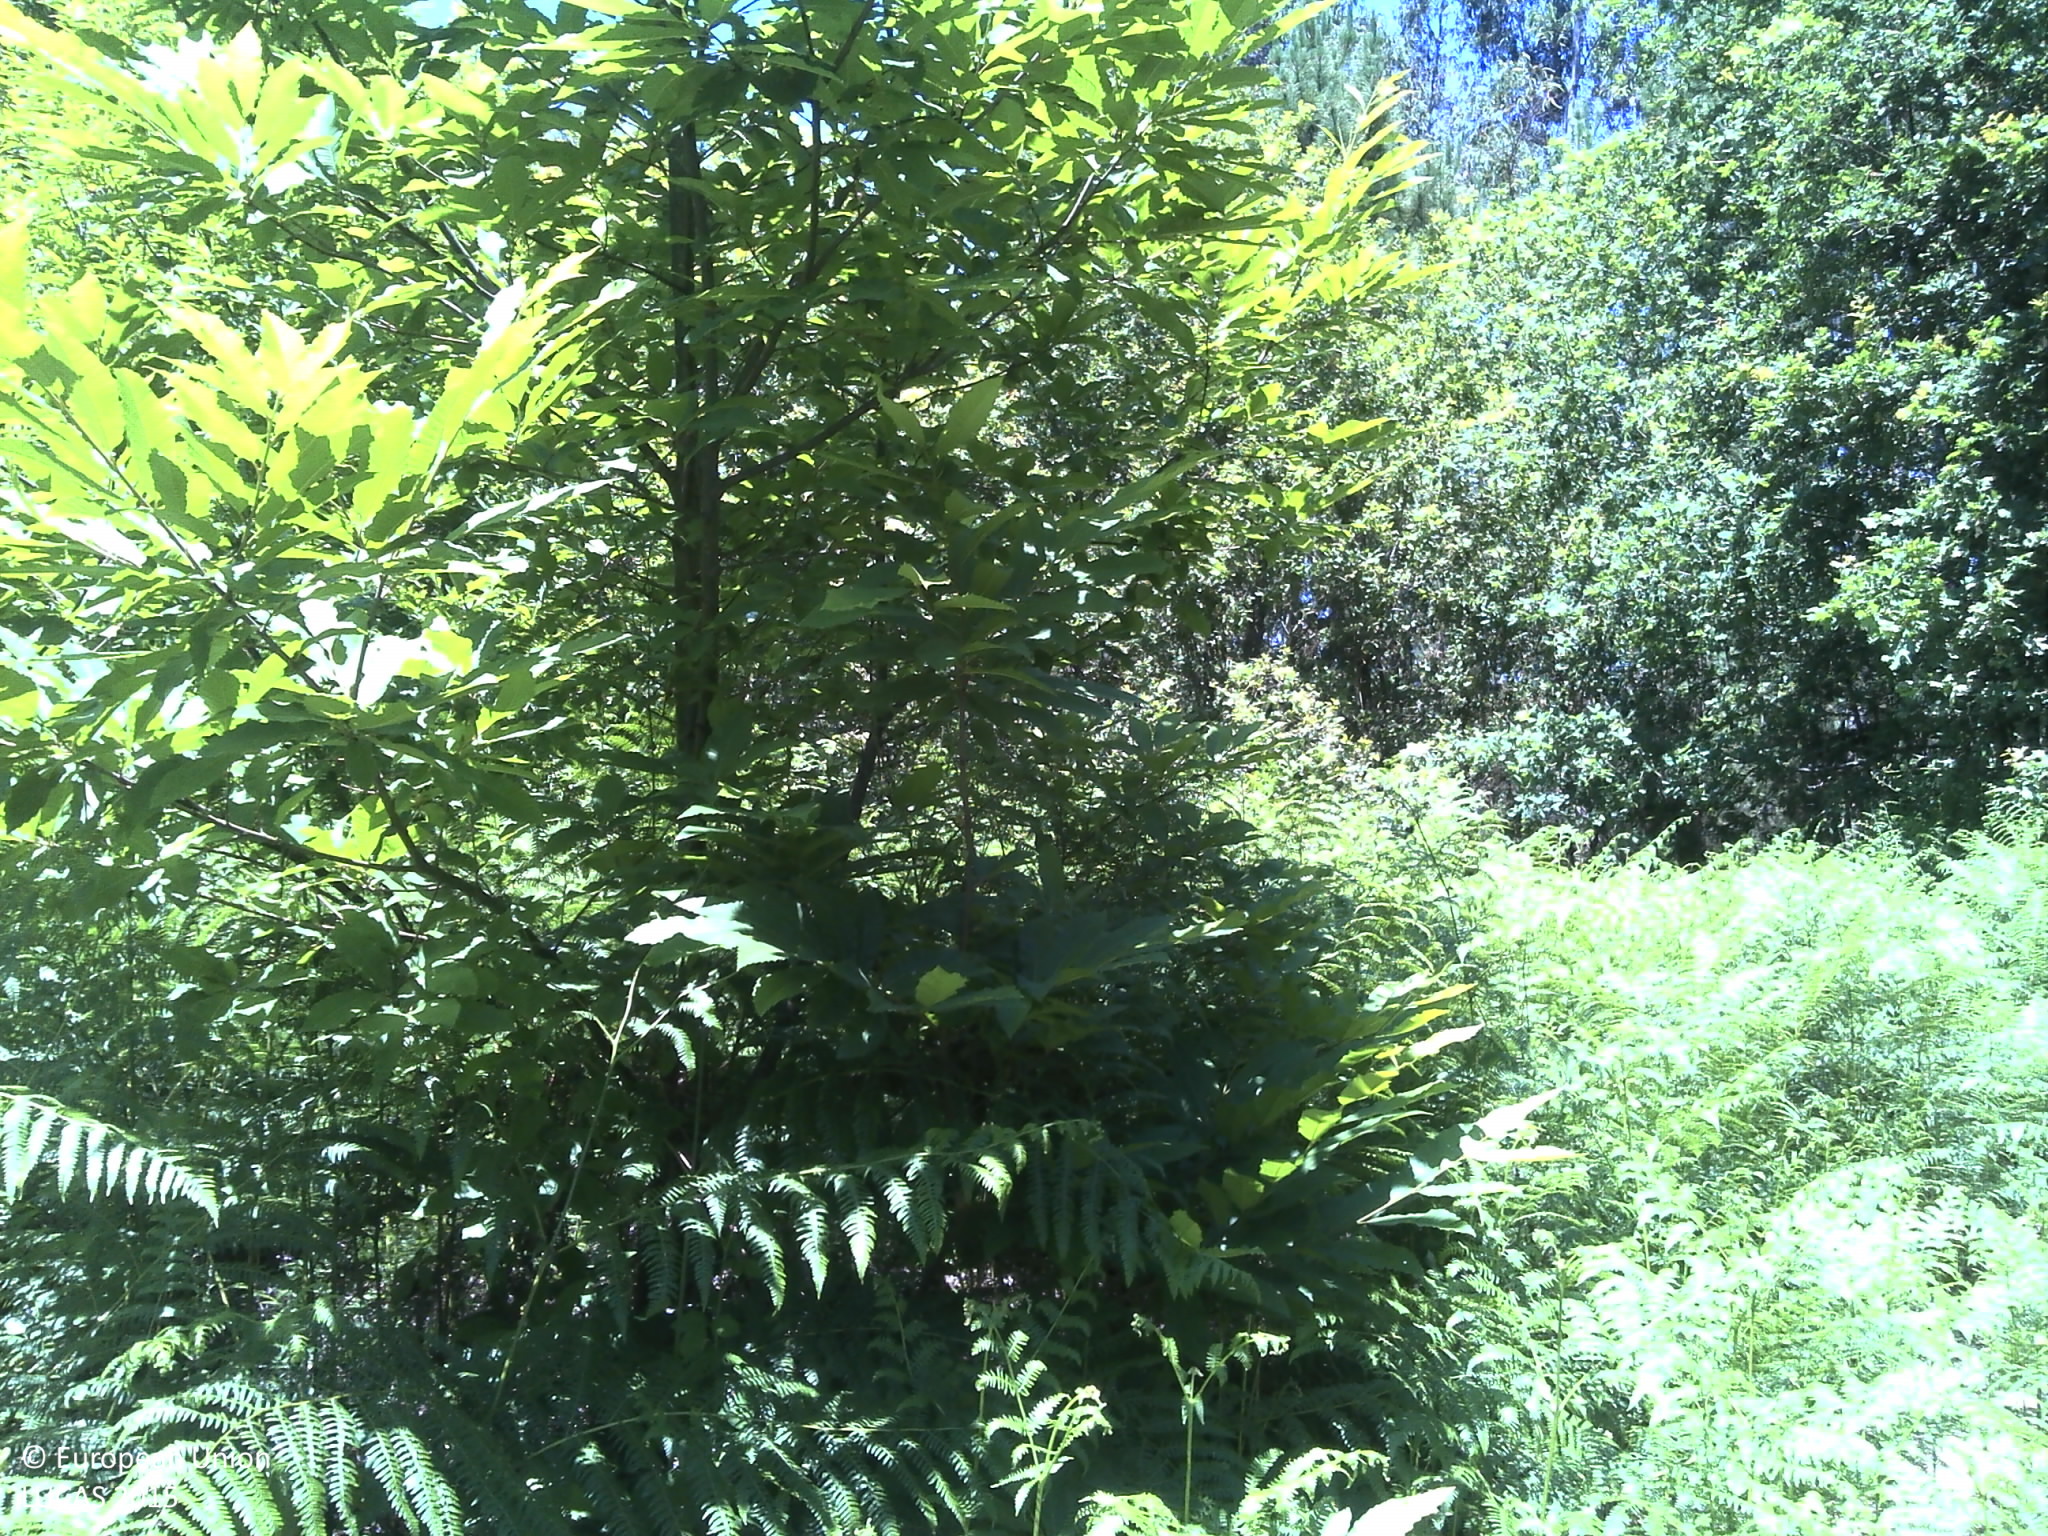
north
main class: Grassland
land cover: Grassland with sparse tree/shrub cover
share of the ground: 25 - 50 %
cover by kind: herbaceous plants 50 %, unconsolidated bare surface 35 %, shrubs 10 %, broadleaved forest trees 5 %
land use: Semi-natural and natural areas not in use
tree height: > 5 m
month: June
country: PT
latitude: 40.6657
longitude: -8.0490
